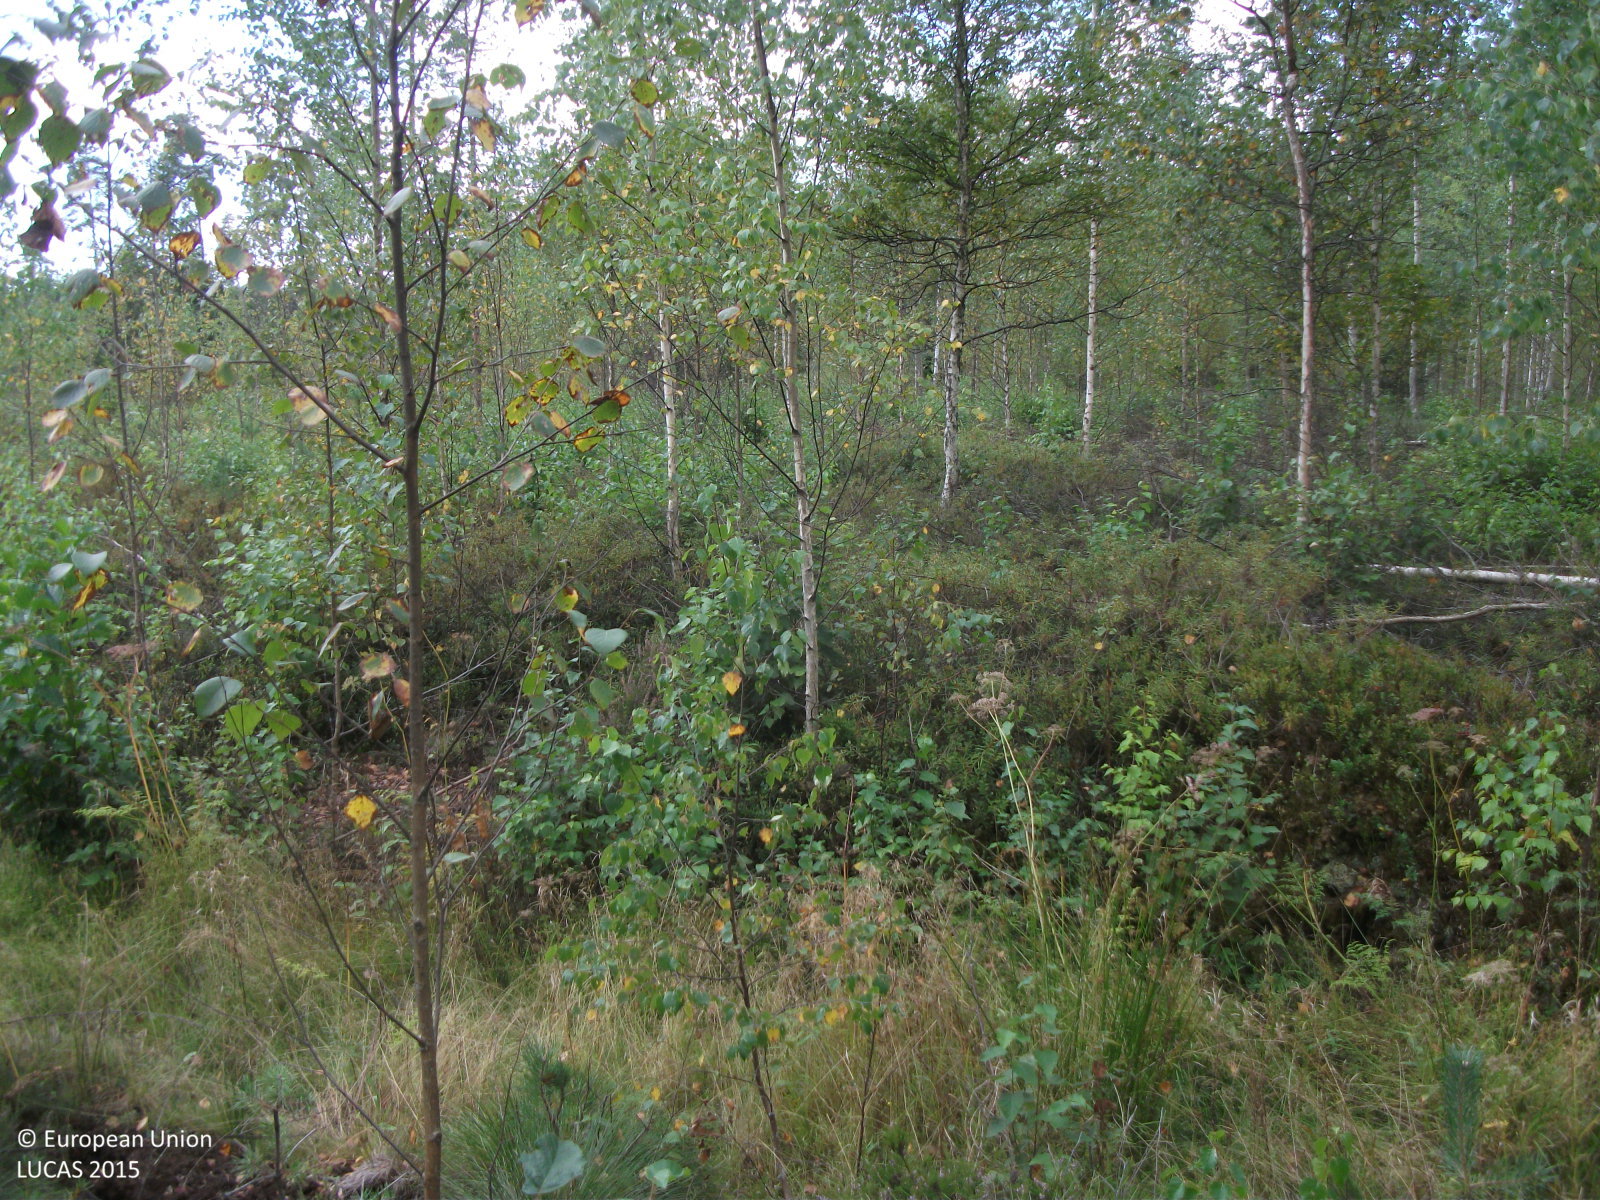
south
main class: Woodland
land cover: Broadleaved woodland
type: non-riverine alder, birch or aspen forest
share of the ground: 50 - 75 %
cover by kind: broadleaved forest trees 60 %, shrubs 20 %, herbaceous plants 10 %, lichens and mosses 10 %
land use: Forestry
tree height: < 5 m
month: September
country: LV
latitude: 56.5639
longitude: 26.2001
